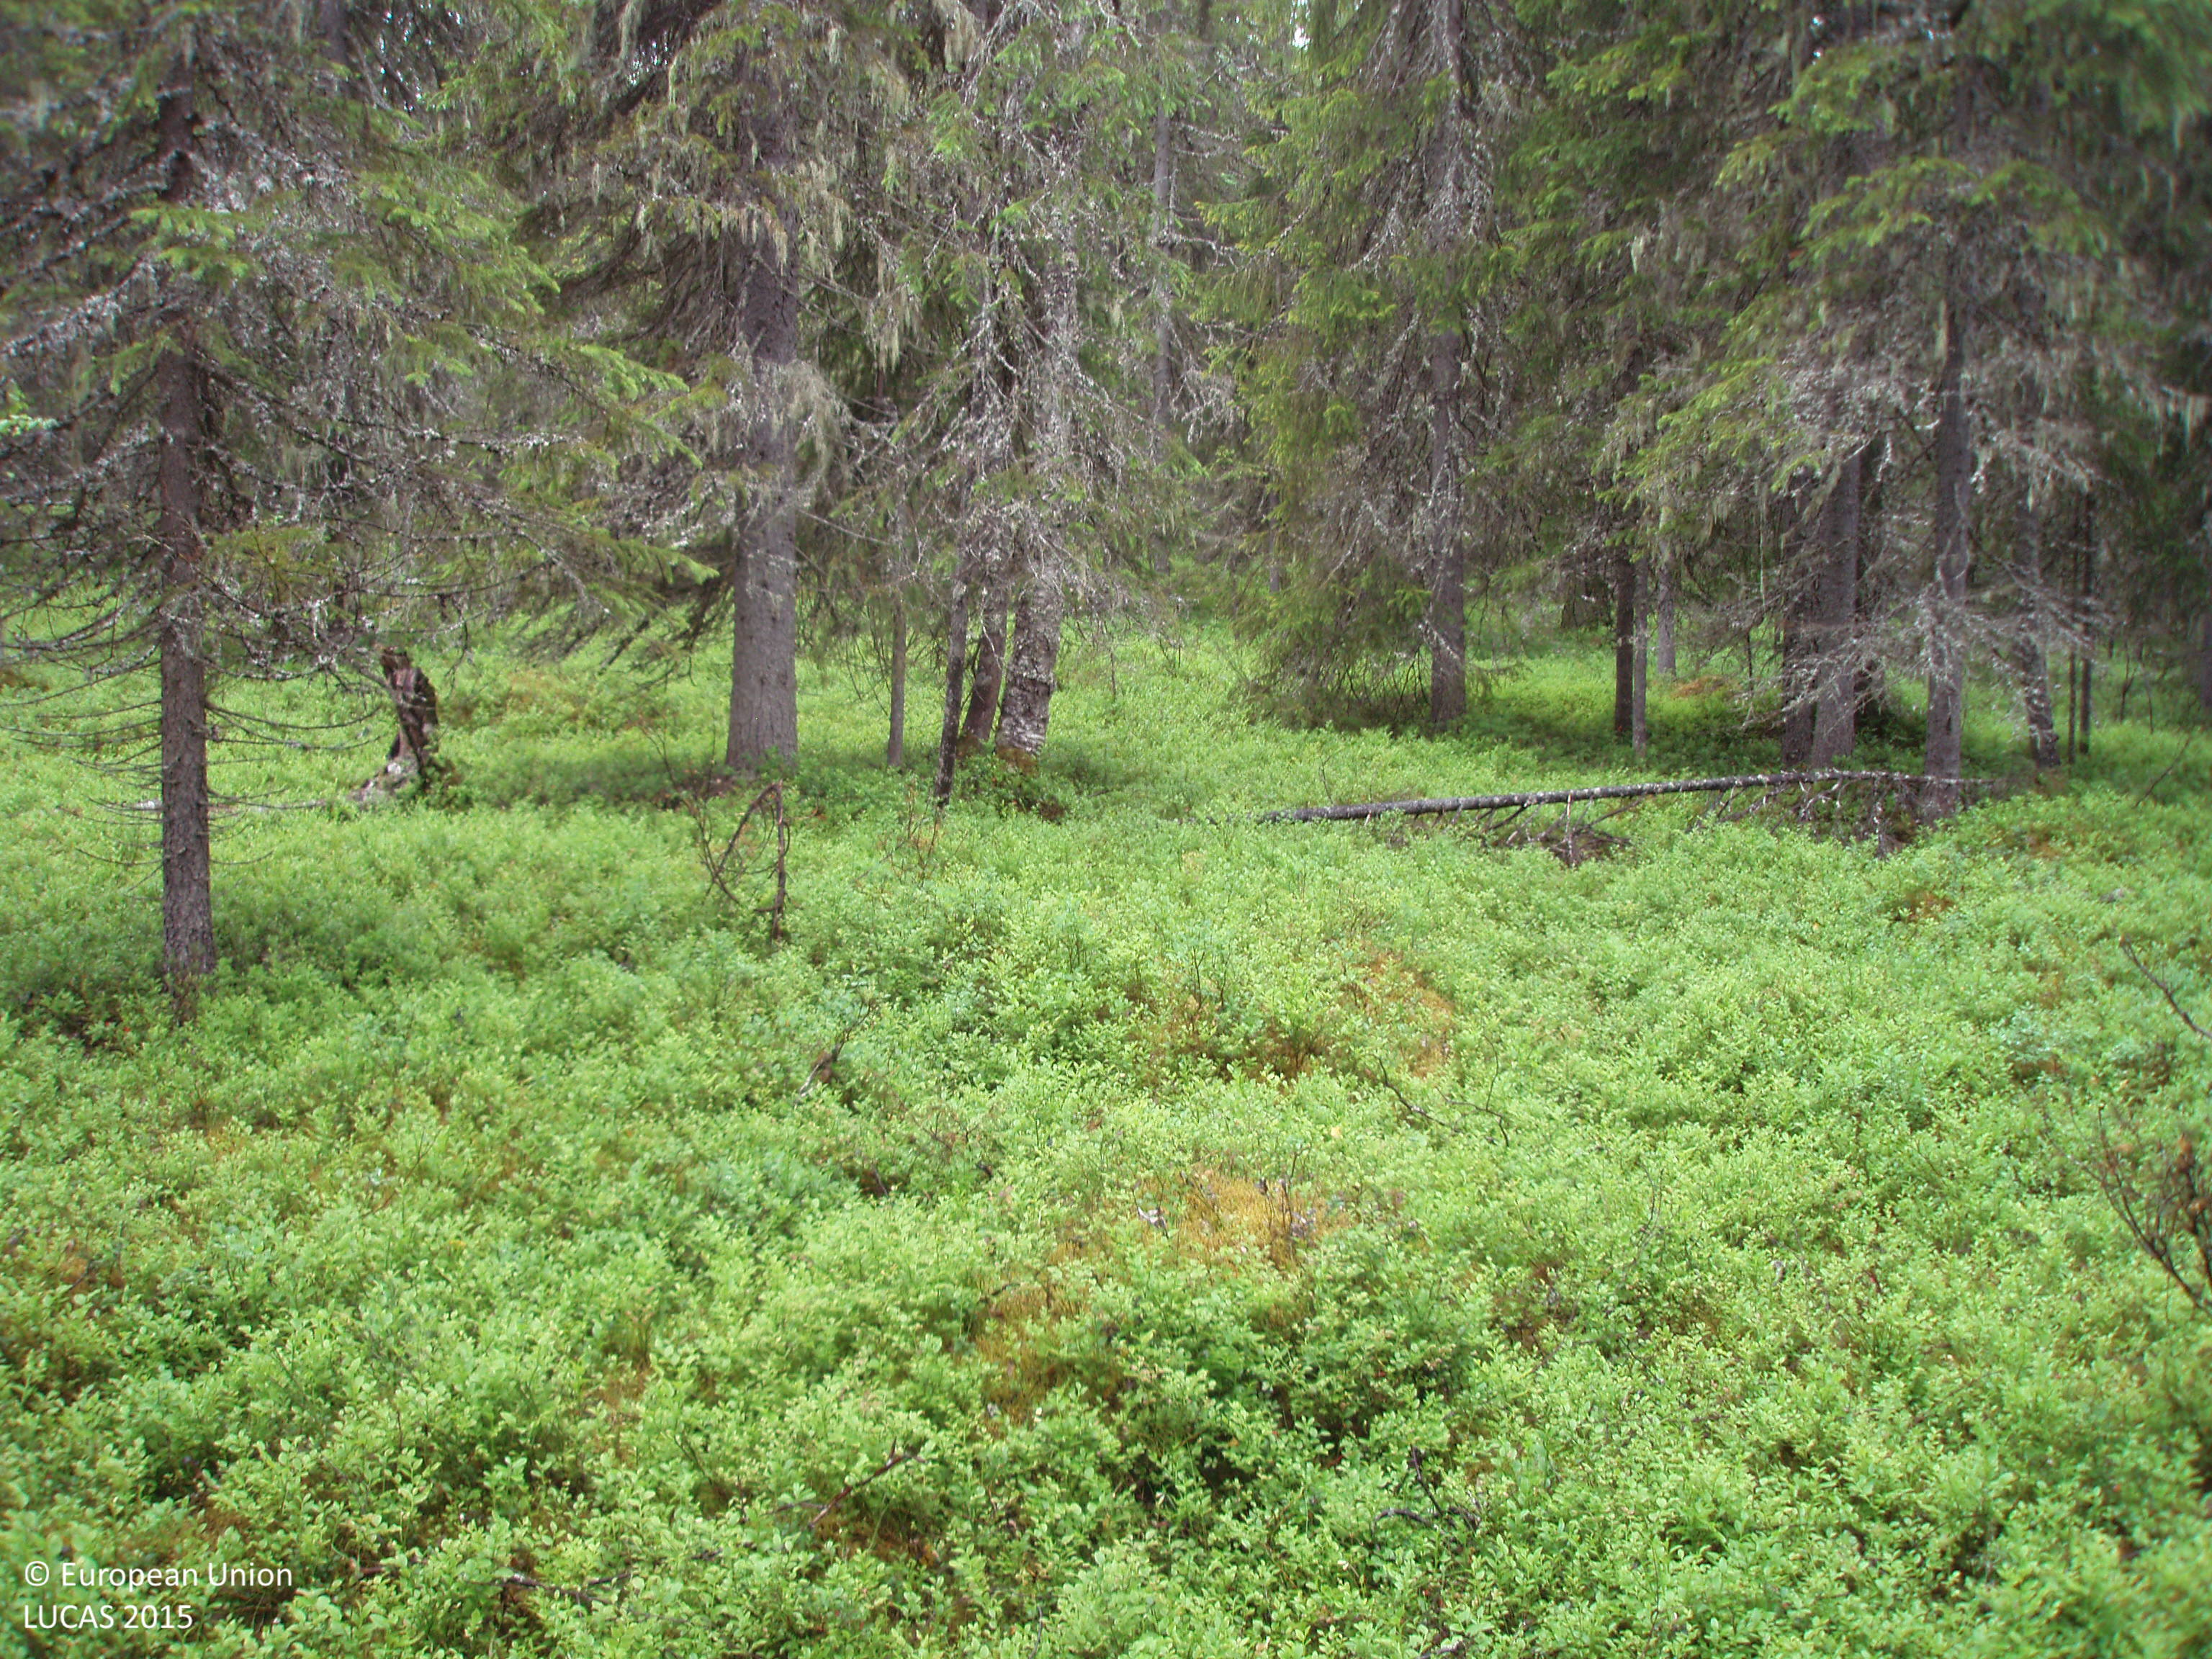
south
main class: Woodland
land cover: Spruce dominated coniferous woodland
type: boreal forest
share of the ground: > 75 %
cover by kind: coniferous forest trees 75 %, shrubs 25 %
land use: Forestry
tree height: > 5 m
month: August
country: FI
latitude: 65.6226
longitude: 27.5651
